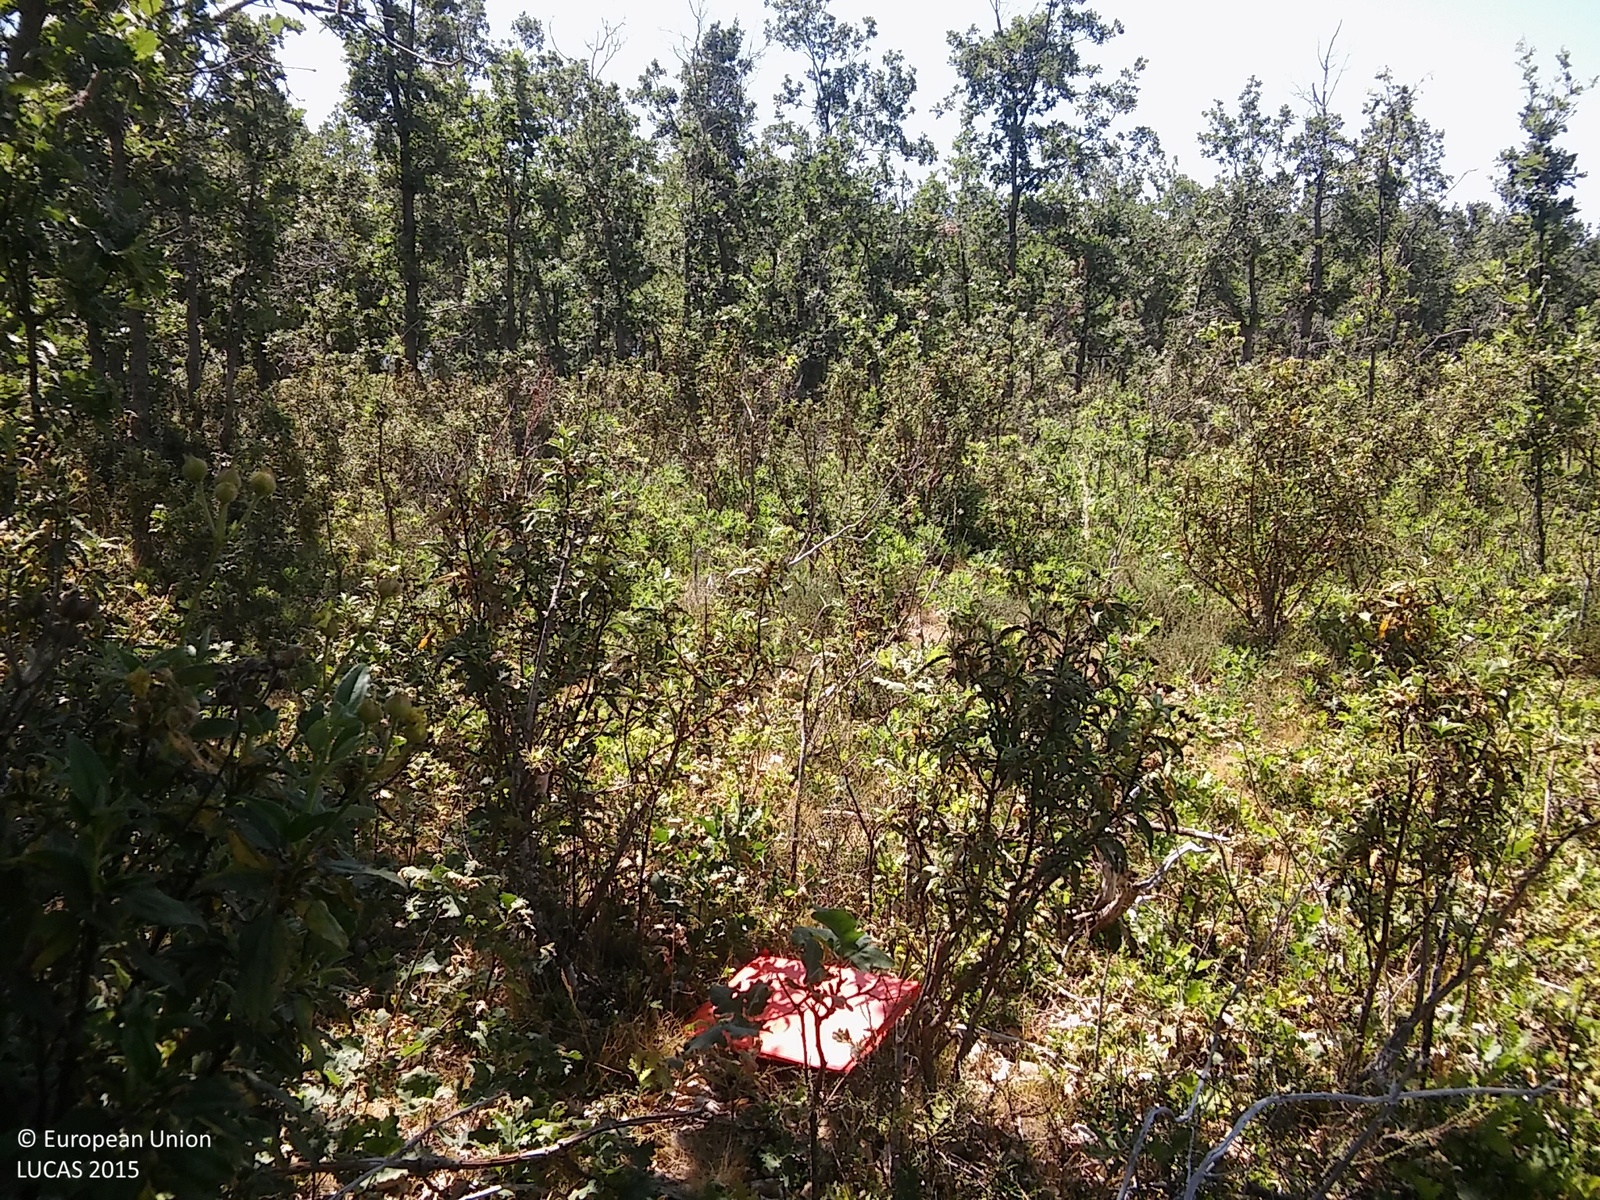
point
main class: Woodland
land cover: Broadleaved woodland
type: acidophilous oak and oak-birch forest
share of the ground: 25 - 50 %
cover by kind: shrubs 40 %, broadleaved forest trees 30 %, herbaceous plants 30 %
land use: Forestry
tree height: > 5 m
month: July
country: ES
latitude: 41.2880
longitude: -3.5027
